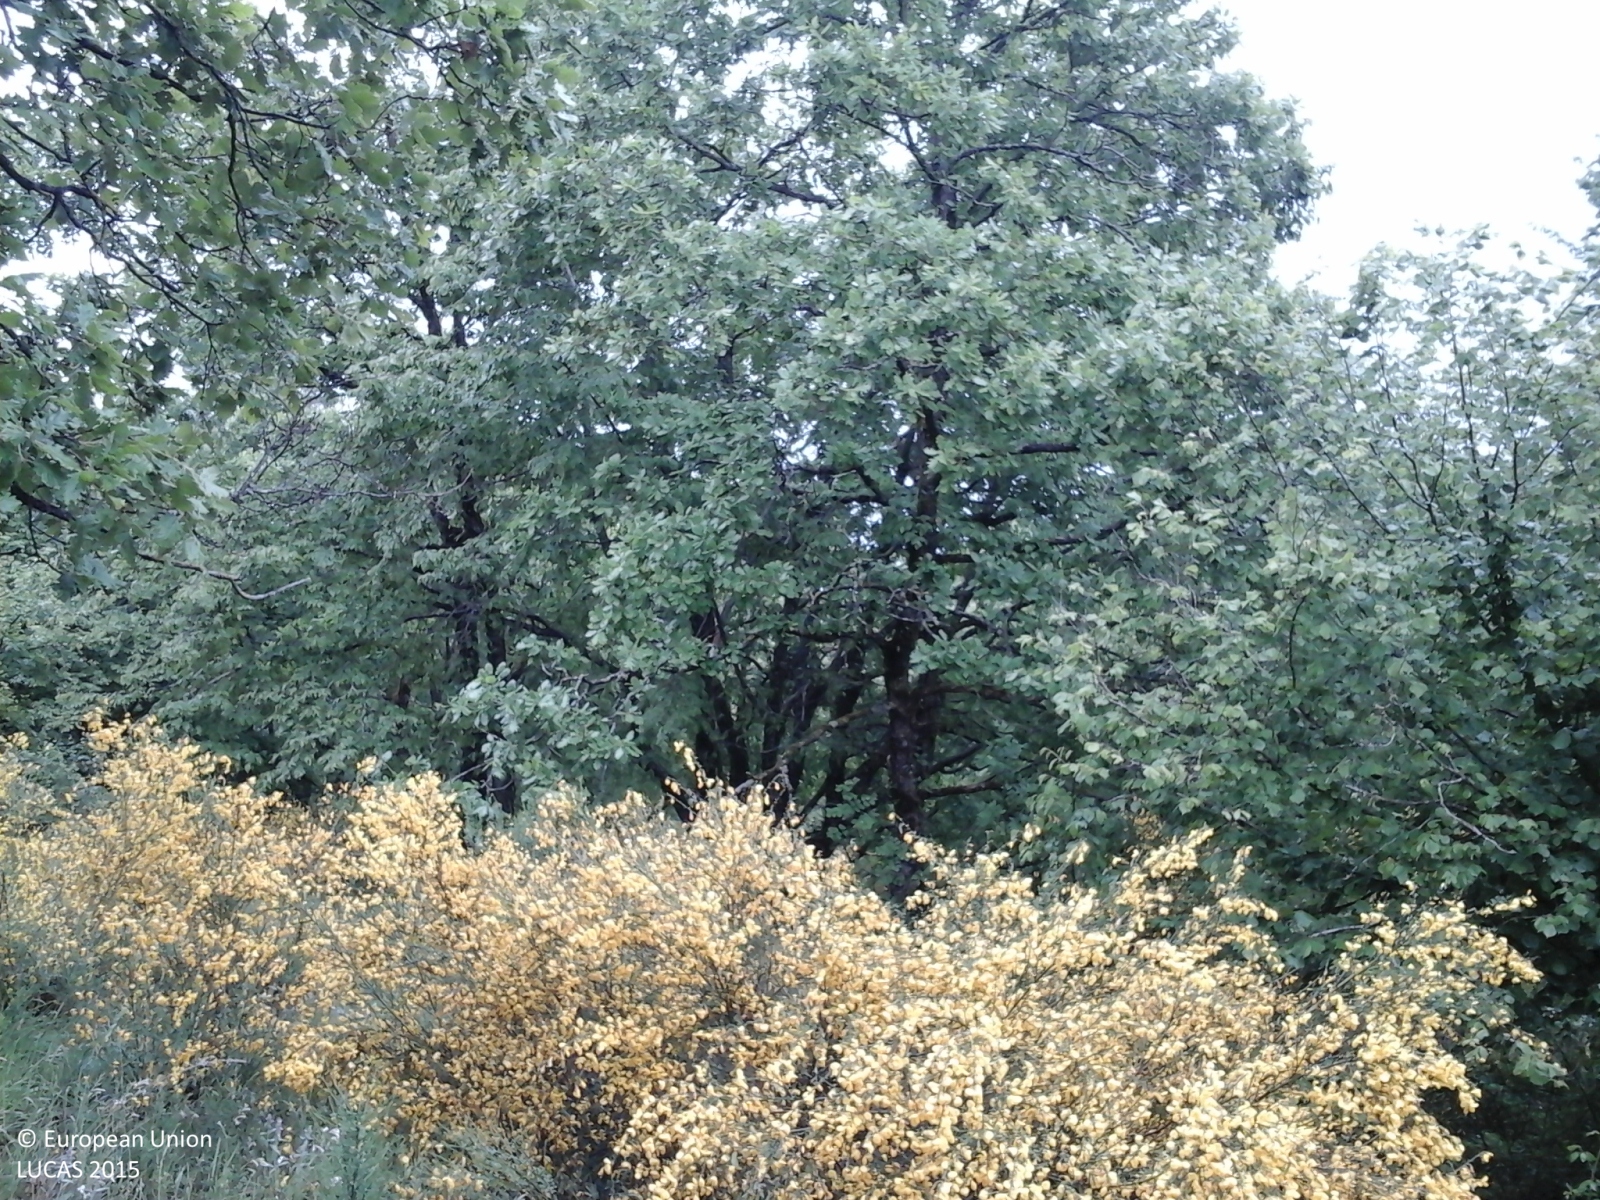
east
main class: Woodland
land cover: Broadleaved woodland
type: thermophilous deciduous forest
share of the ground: 50 - 75 %
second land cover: Grassland without tree/shrub cover
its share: 50 - 75 %
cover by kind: broadleaved forest trees 90 %, shrubs 5 %, herbaceous plants 5 %
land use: Forestry
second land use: Agriculture (excluding fallow land and kitchen gardens)
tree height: > 5 m
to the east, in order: Broadleaved woodland; Grassland without tree/shrub cover; Broadleaved woodland; Shrubland with sparse tree cover; Grassland with sparse tree/shrub cover
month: May
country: IT
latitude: 41.8267
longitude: 13.1790
